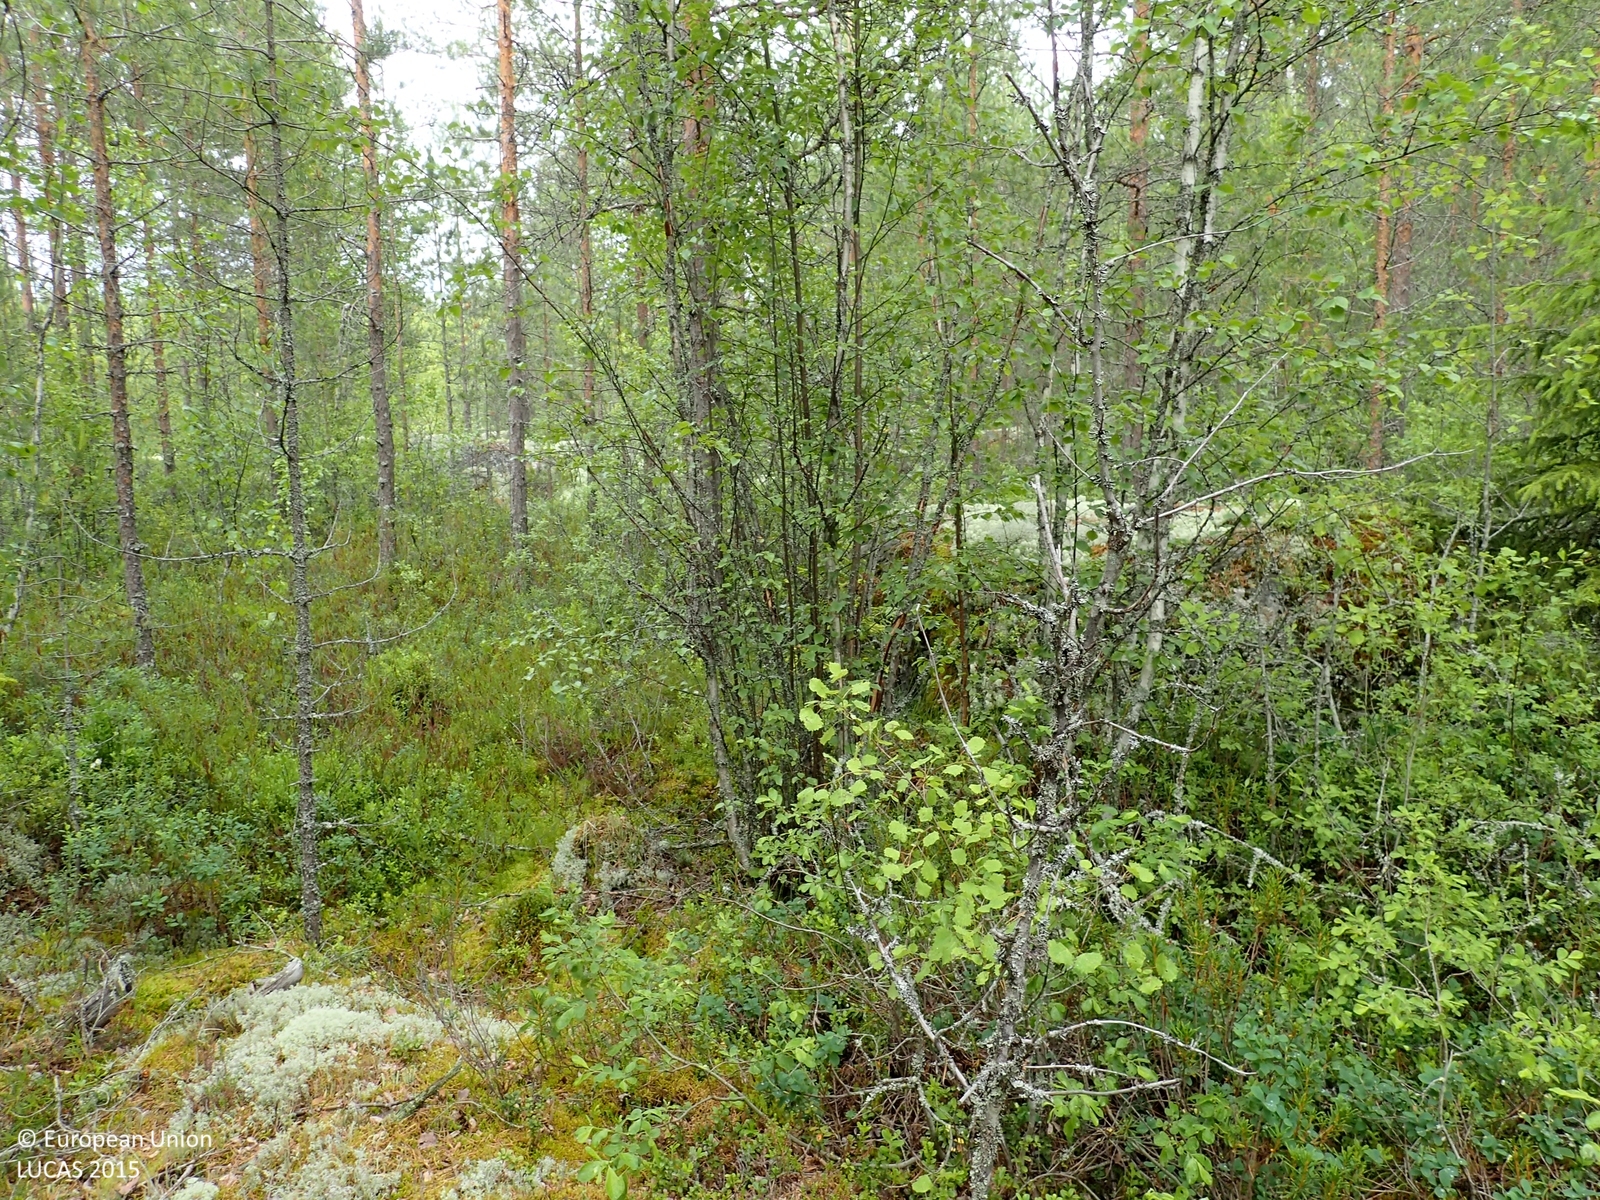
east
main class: Woodland
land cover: Pine dominated coniferous woodland
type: boreal forest
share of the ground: 50 - 75 %
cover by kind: coniferous forest trees 45 %, shrubs 40 %, lichens and mosses 10 %, broadleaved forest trees 5 %
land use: Forestry
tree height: < 5 m
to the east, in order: Pine dominated coniferous woodland; Ditches and canals; Shruby margins; Paved roads, cycling and walking lanes; Shruby margins; Pine dominated coniferous woodland; Pine dominated mixed woodland; Spruce dominated mixed woodland; Ditches and canals; Spruce dominated mixed woodland; Ditches and canals; Pine dominated mixed woodland
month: July
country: FI
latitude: 62.8584
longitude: 21.5752
